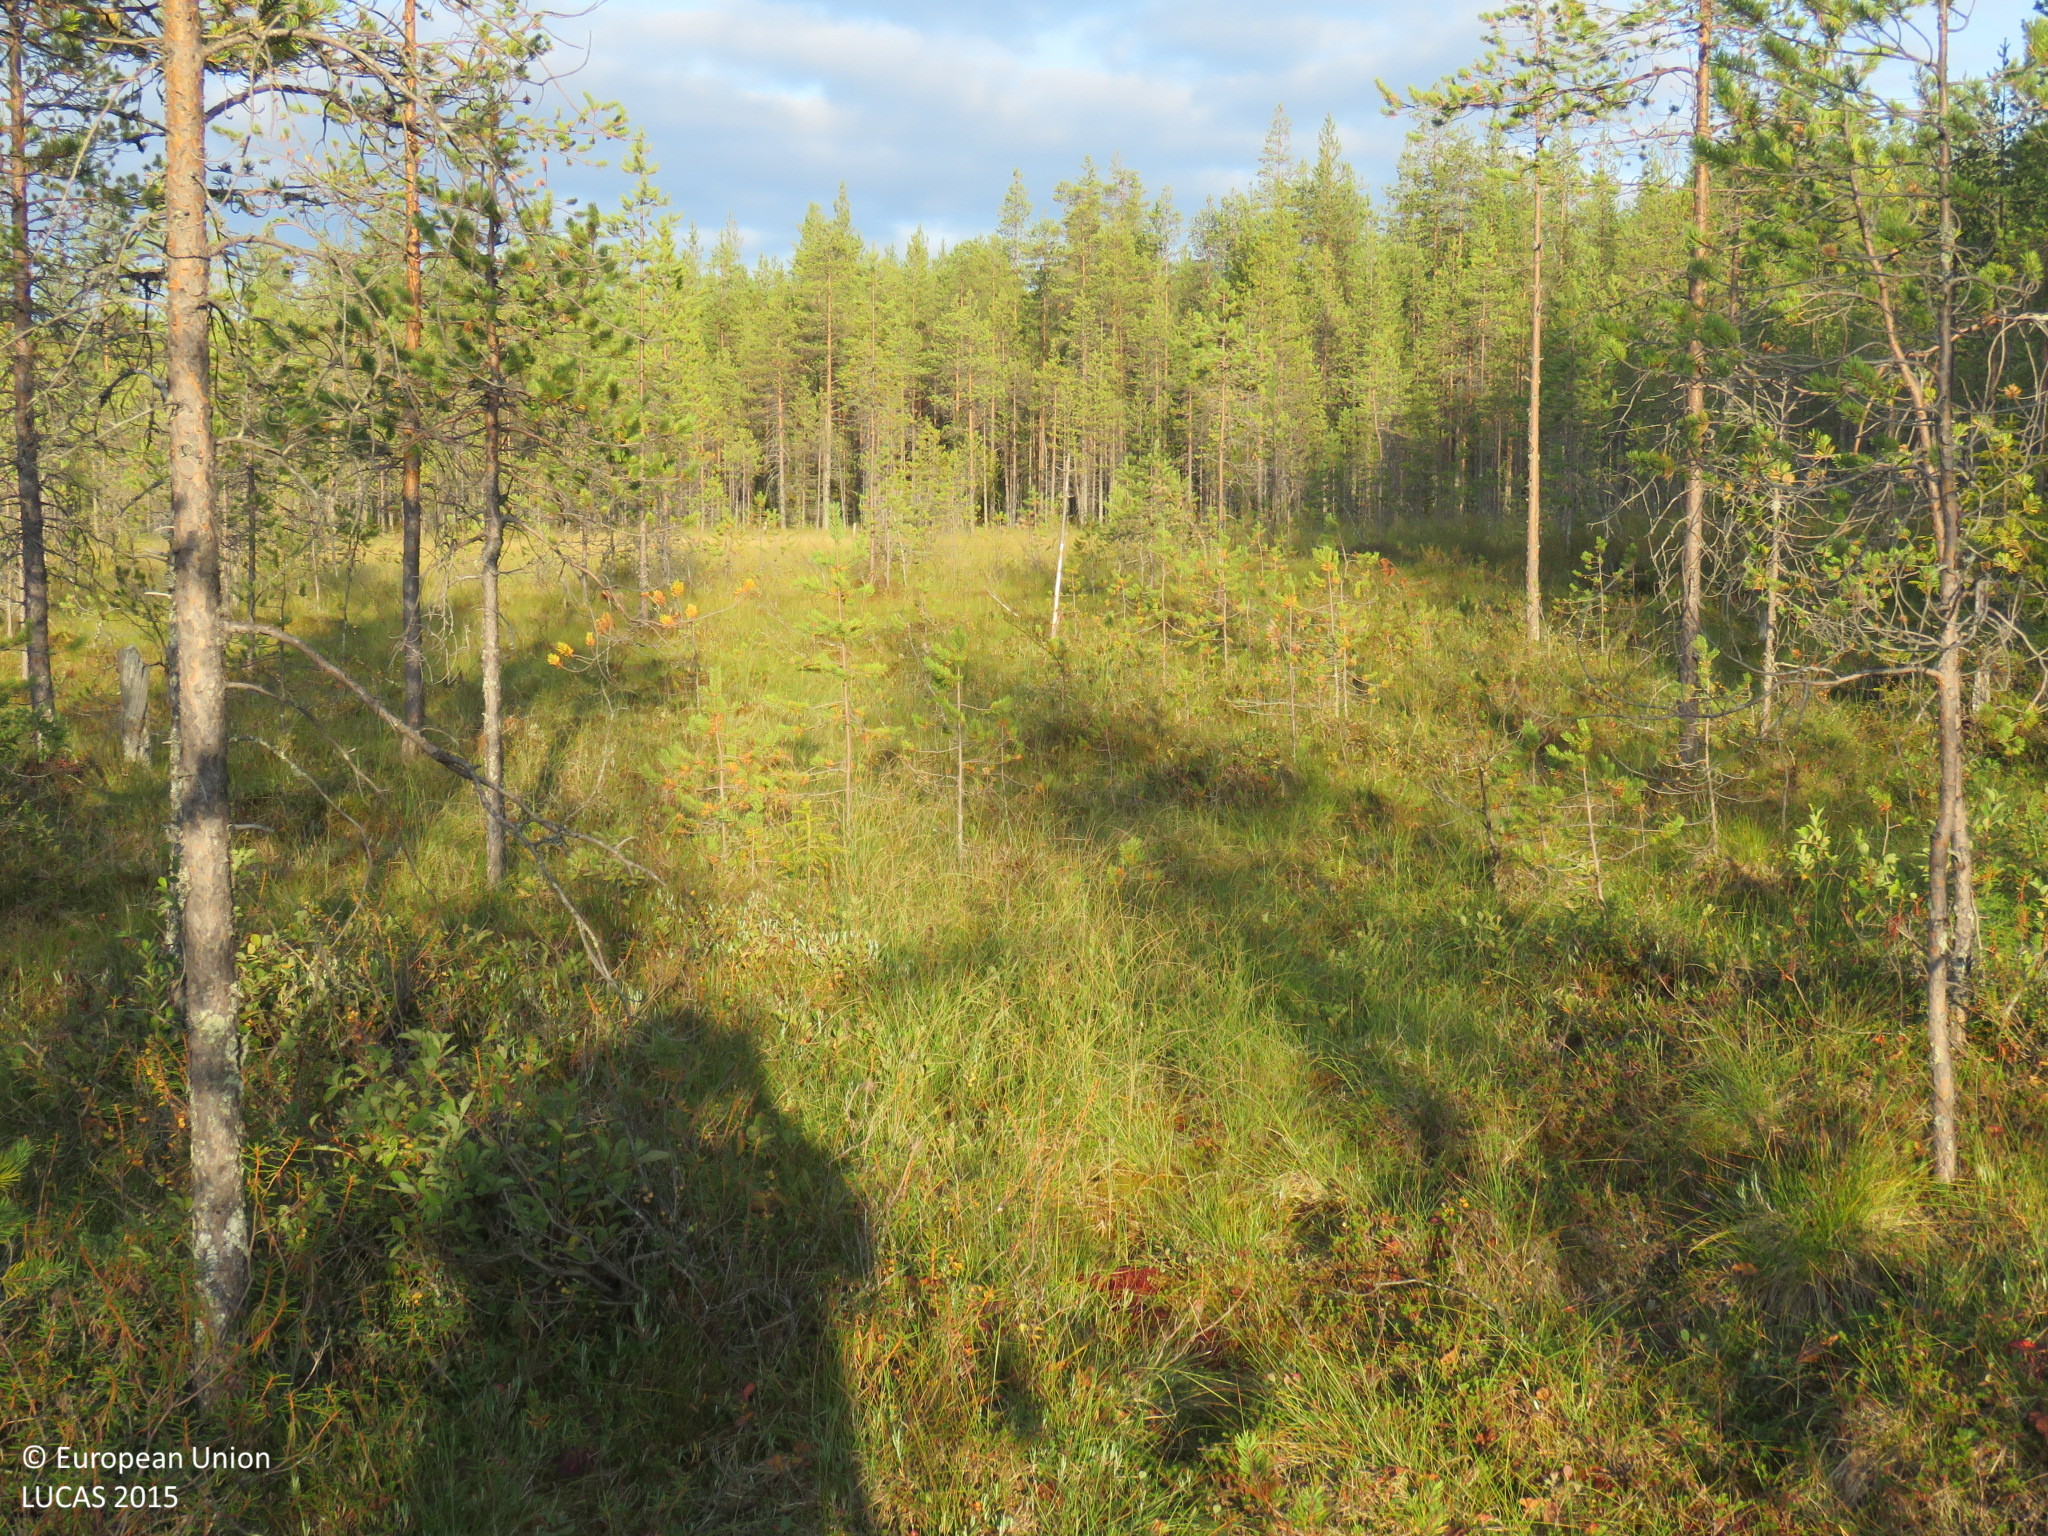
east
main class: Woodland
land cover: Pine dominated coniferous woodland
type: mire and swamp forests
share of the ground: 25 - 50 %
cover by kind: coniferous forest trees 45 %, herbaceous plants 25 %, shrubs 20 %, lichens and mosses 10 %
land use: Forestry
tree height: > 5 m
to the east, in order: Pine dominated coniferous woodland; Peatbogs; Pine dominated coniferous woodland; Ditches and canals; Pine dominated coniferous woodland; Grassland without tree/shrub cover; Pine dominated coniferous woodland; Peatbogs
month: September
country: FI
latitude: 65.4957
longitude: 27.7026
